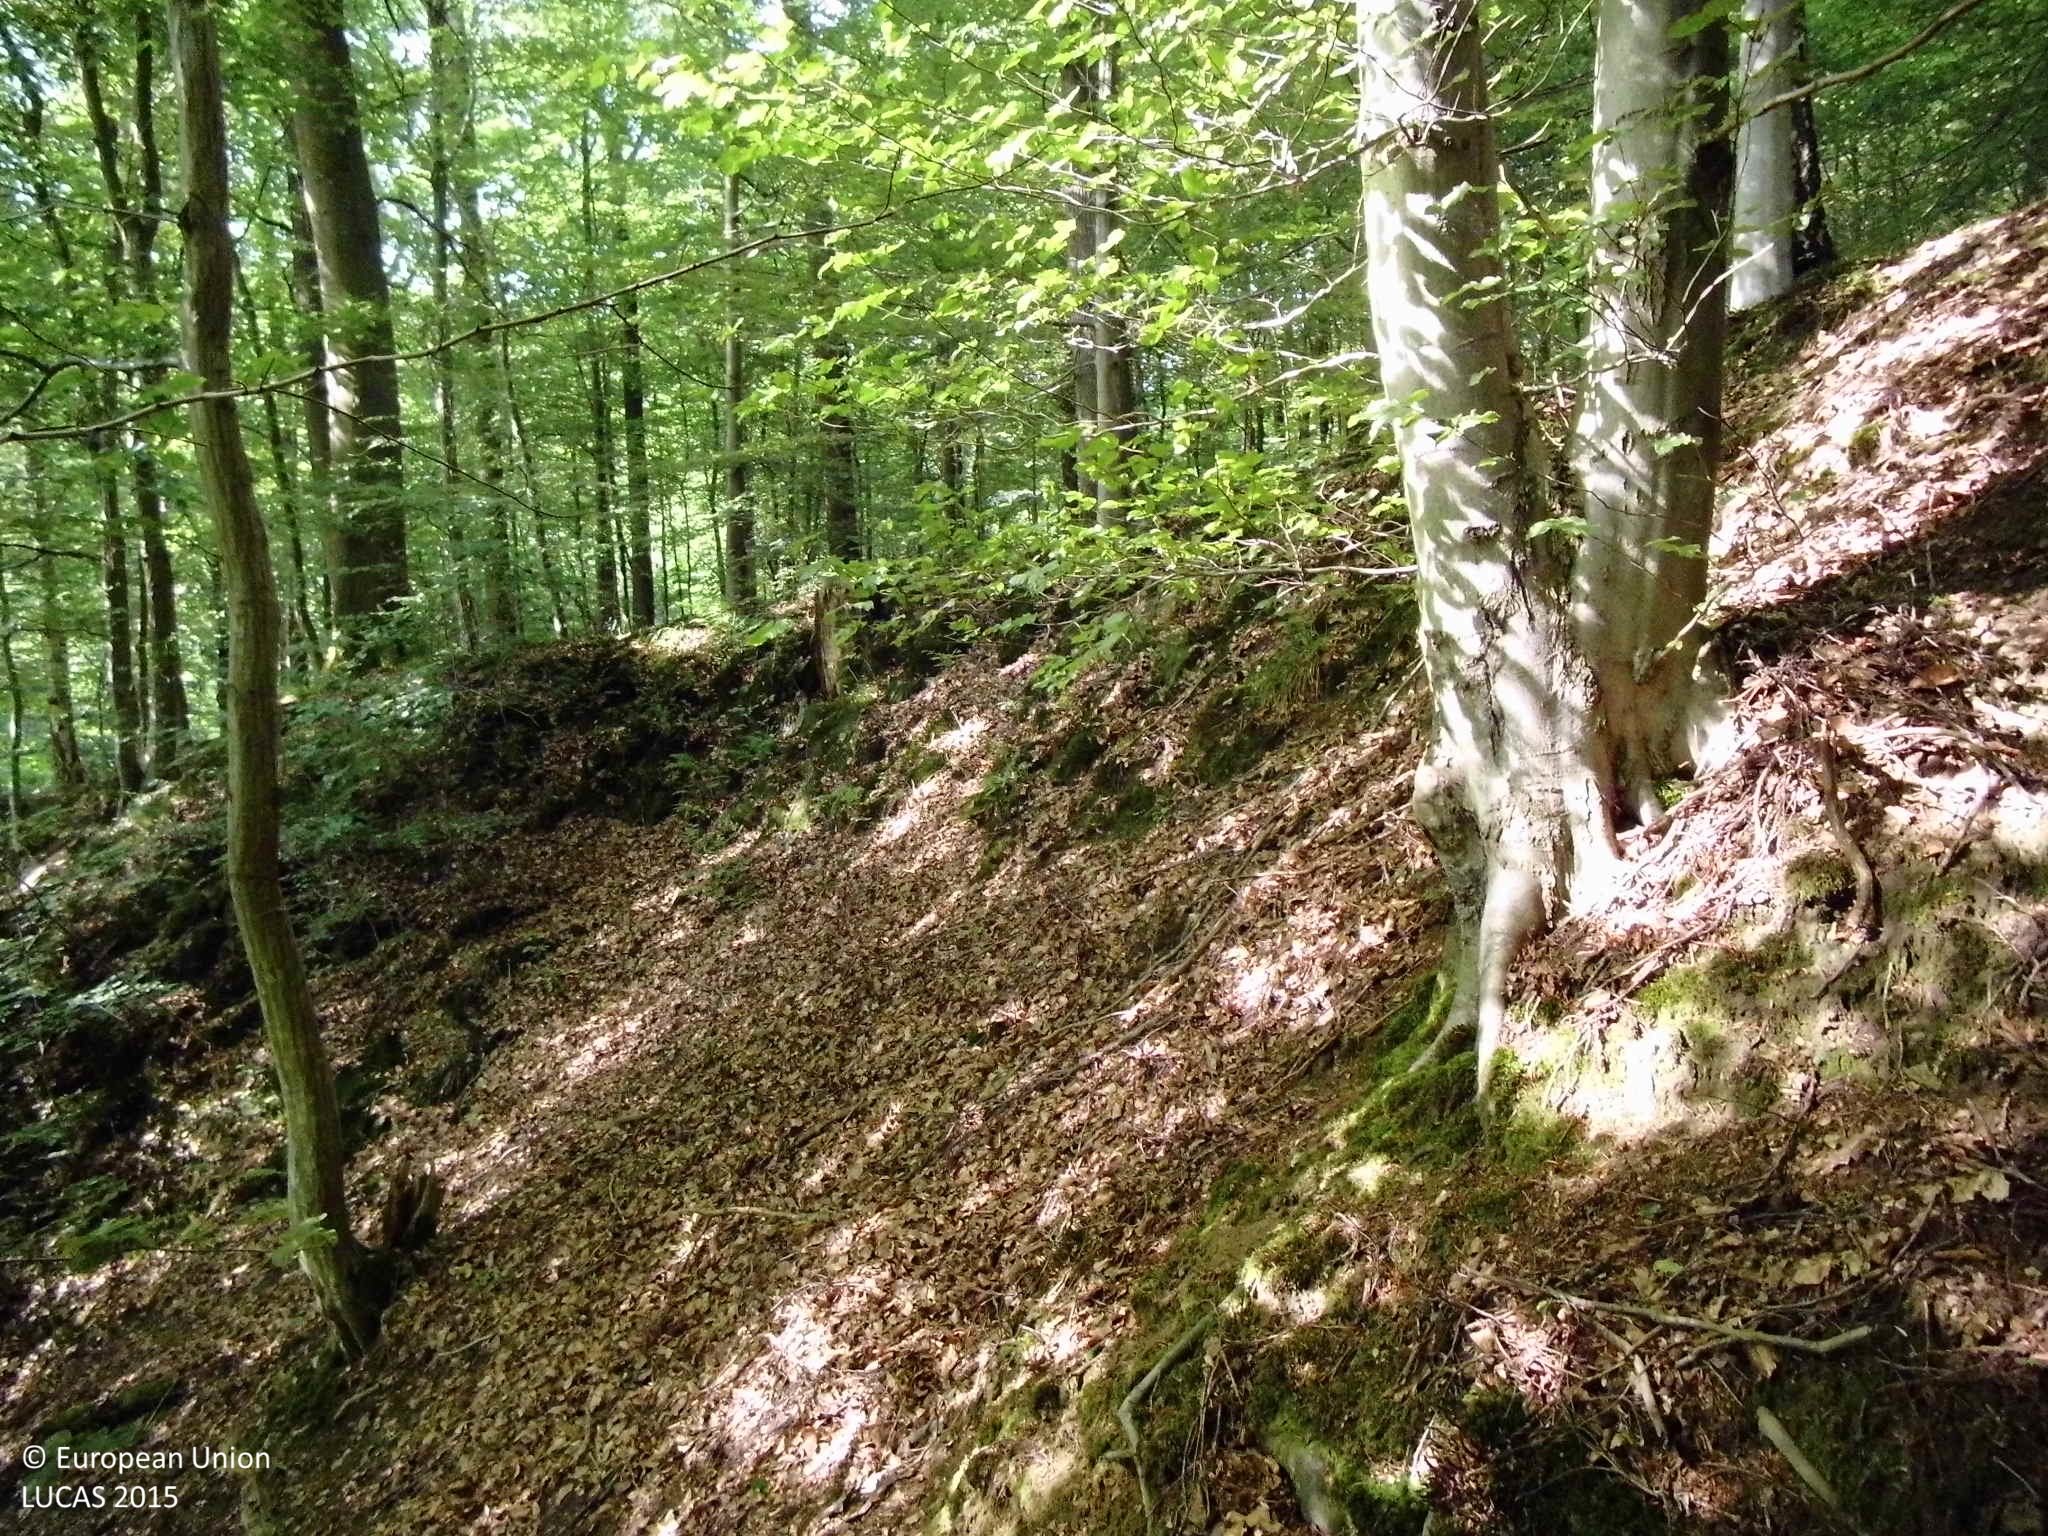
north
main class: Woodland
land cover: Broadleaved woodland
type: beech forest
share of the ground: > 75 %
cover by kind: broadleaved forest trees 90 %, coniferous forest trees 10 %
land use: Forestry
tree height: > 5 m
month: June
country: DE
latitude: 50.7491
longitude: 7.4349
